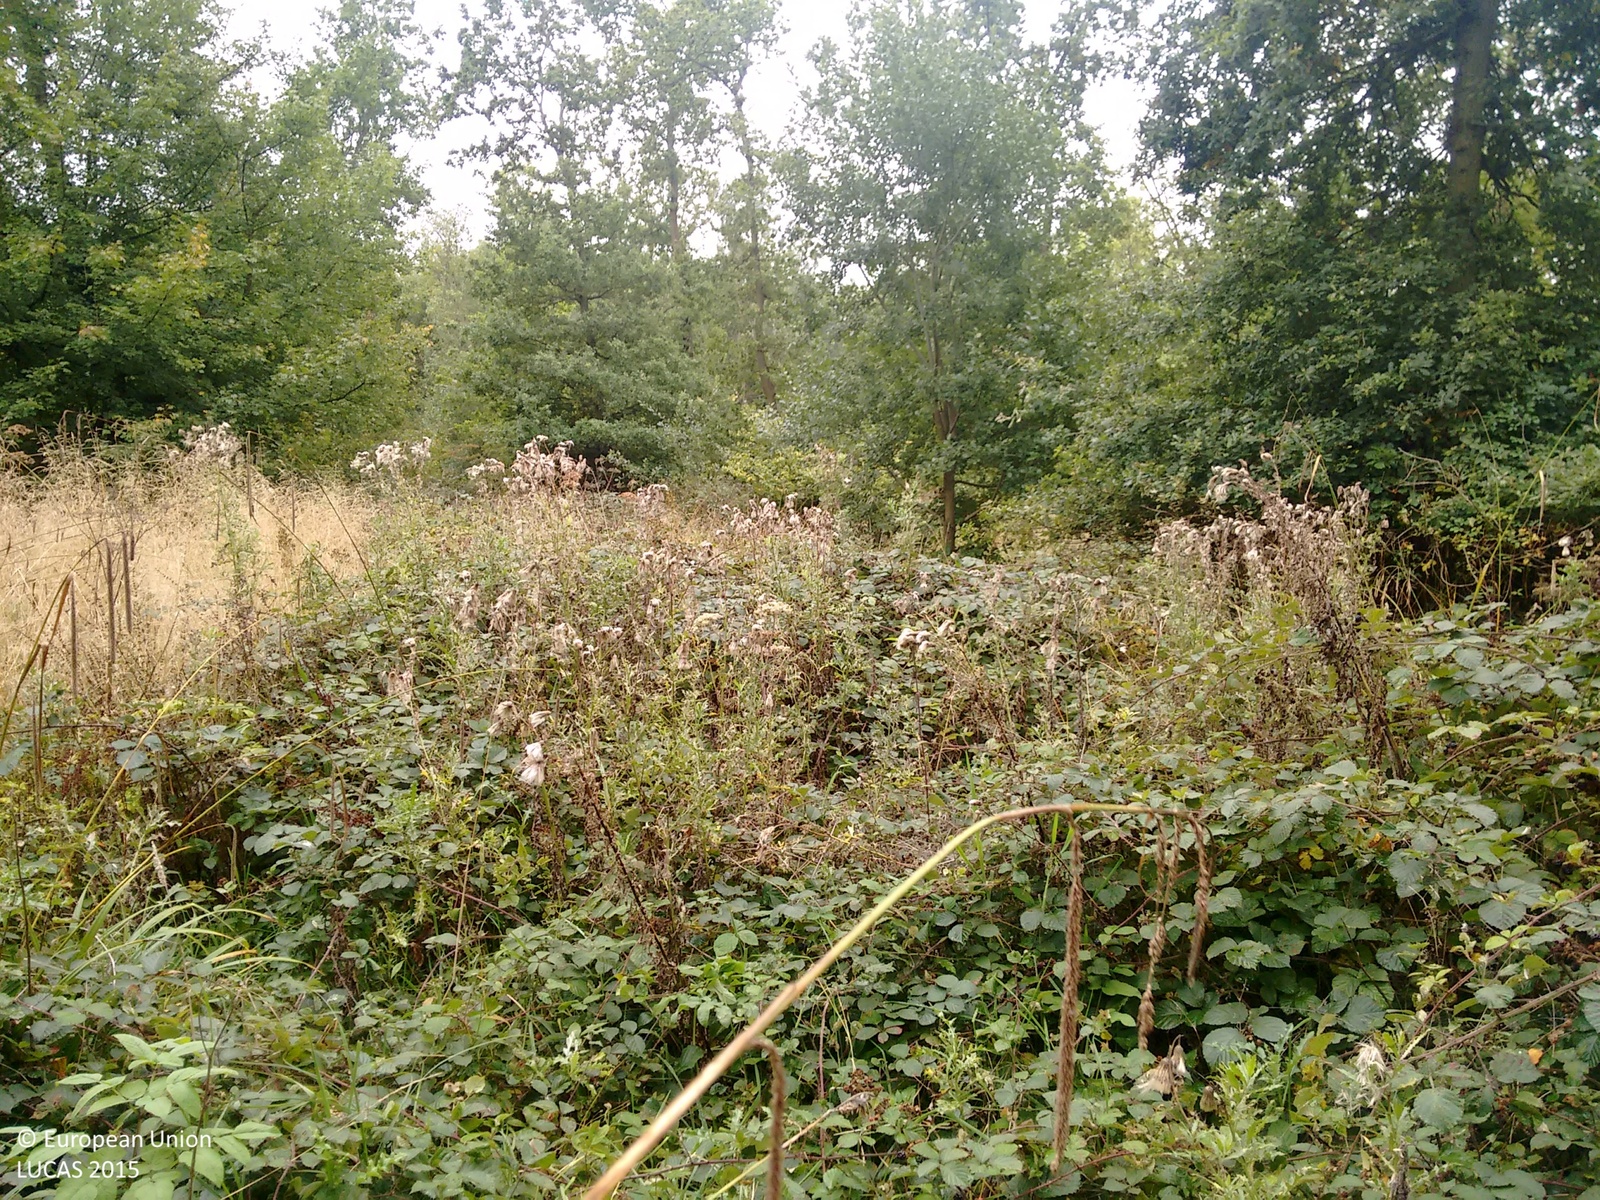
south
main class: Woodland
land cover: Broadleaved woodland
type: mesophytic deciduous forest
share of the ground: 25 - 50 %
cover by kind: shrubs 50 %, broadleaved forest trees 40 %, herbaceous plants 10 %
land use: Forestry
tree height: > 5 m
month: September
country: GB
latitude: 51.9784
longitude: 0.2886
